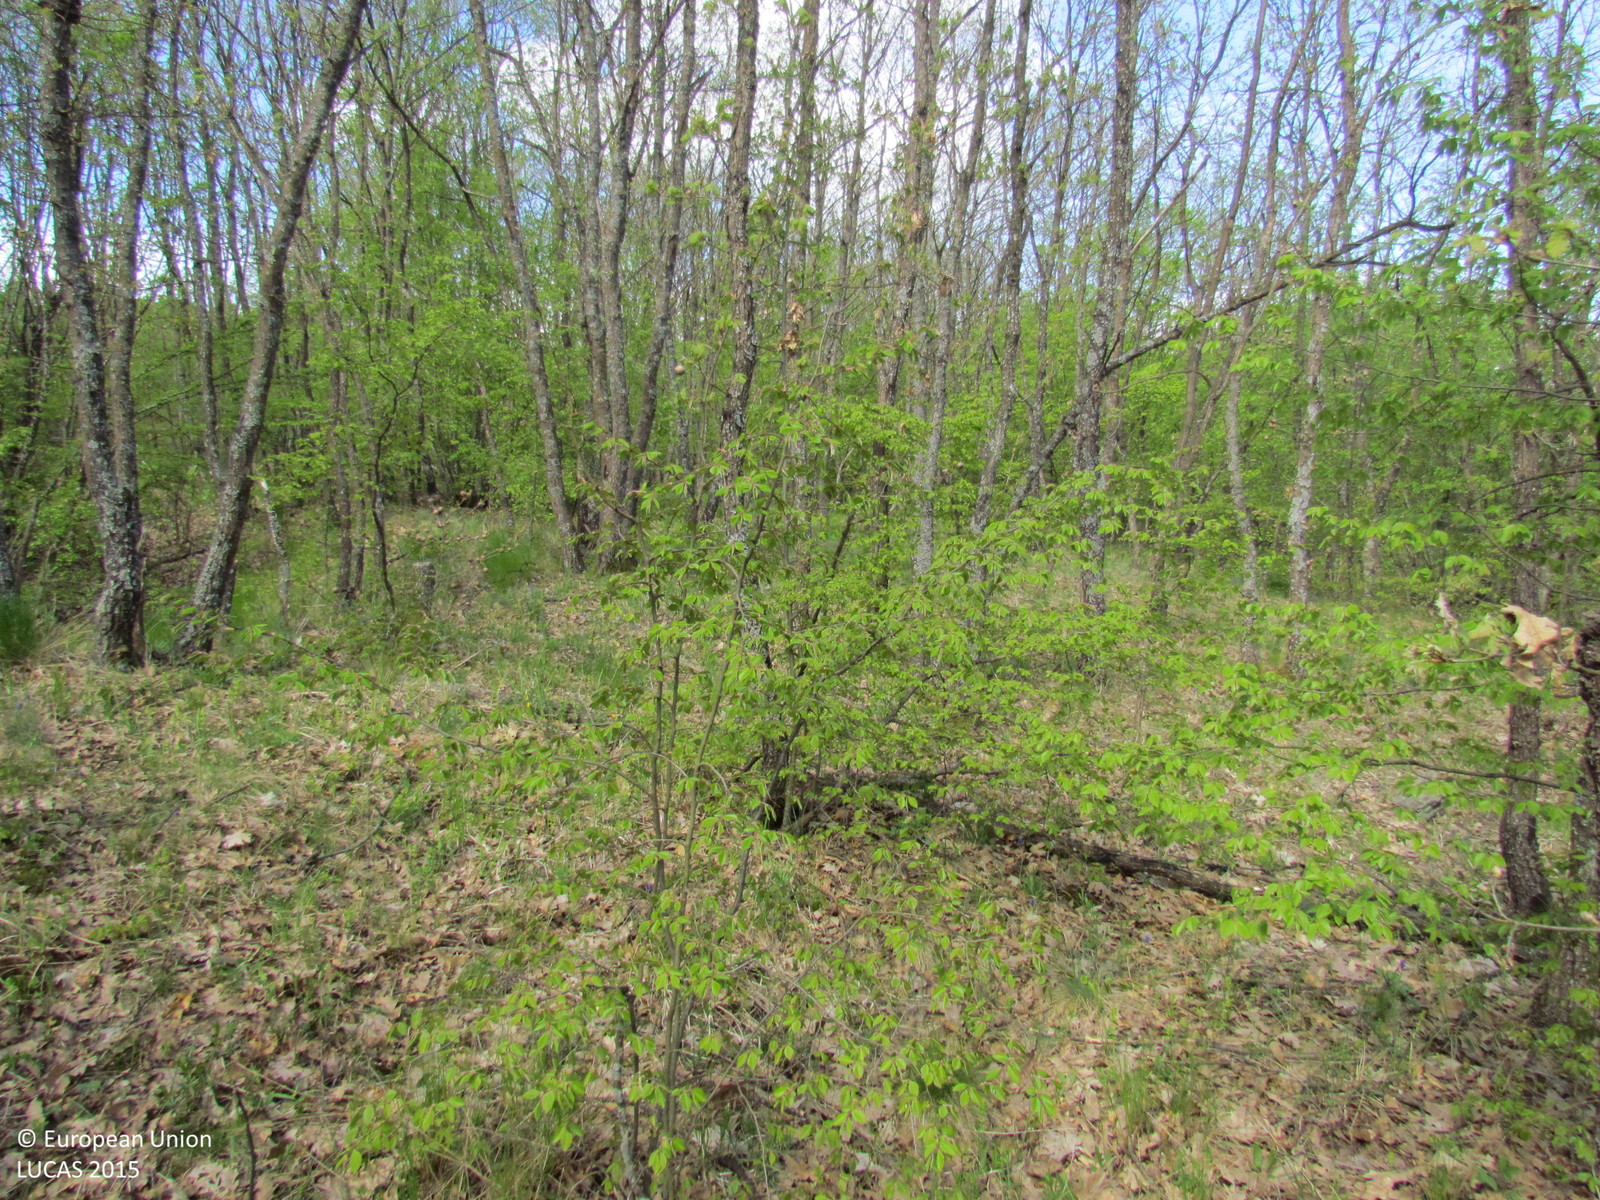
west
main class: Woodland
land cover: Broadleaved woodland
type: mesophytic deciduous forest
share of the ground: 50 - 75 %
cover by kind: broadleaved forest trees 70 %, consolidated bare surface 25 %, herbaceous plants 5 %
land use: Forestry
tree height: > 5 m
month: April
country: BG
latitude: 42.7834
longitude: 26.5881
